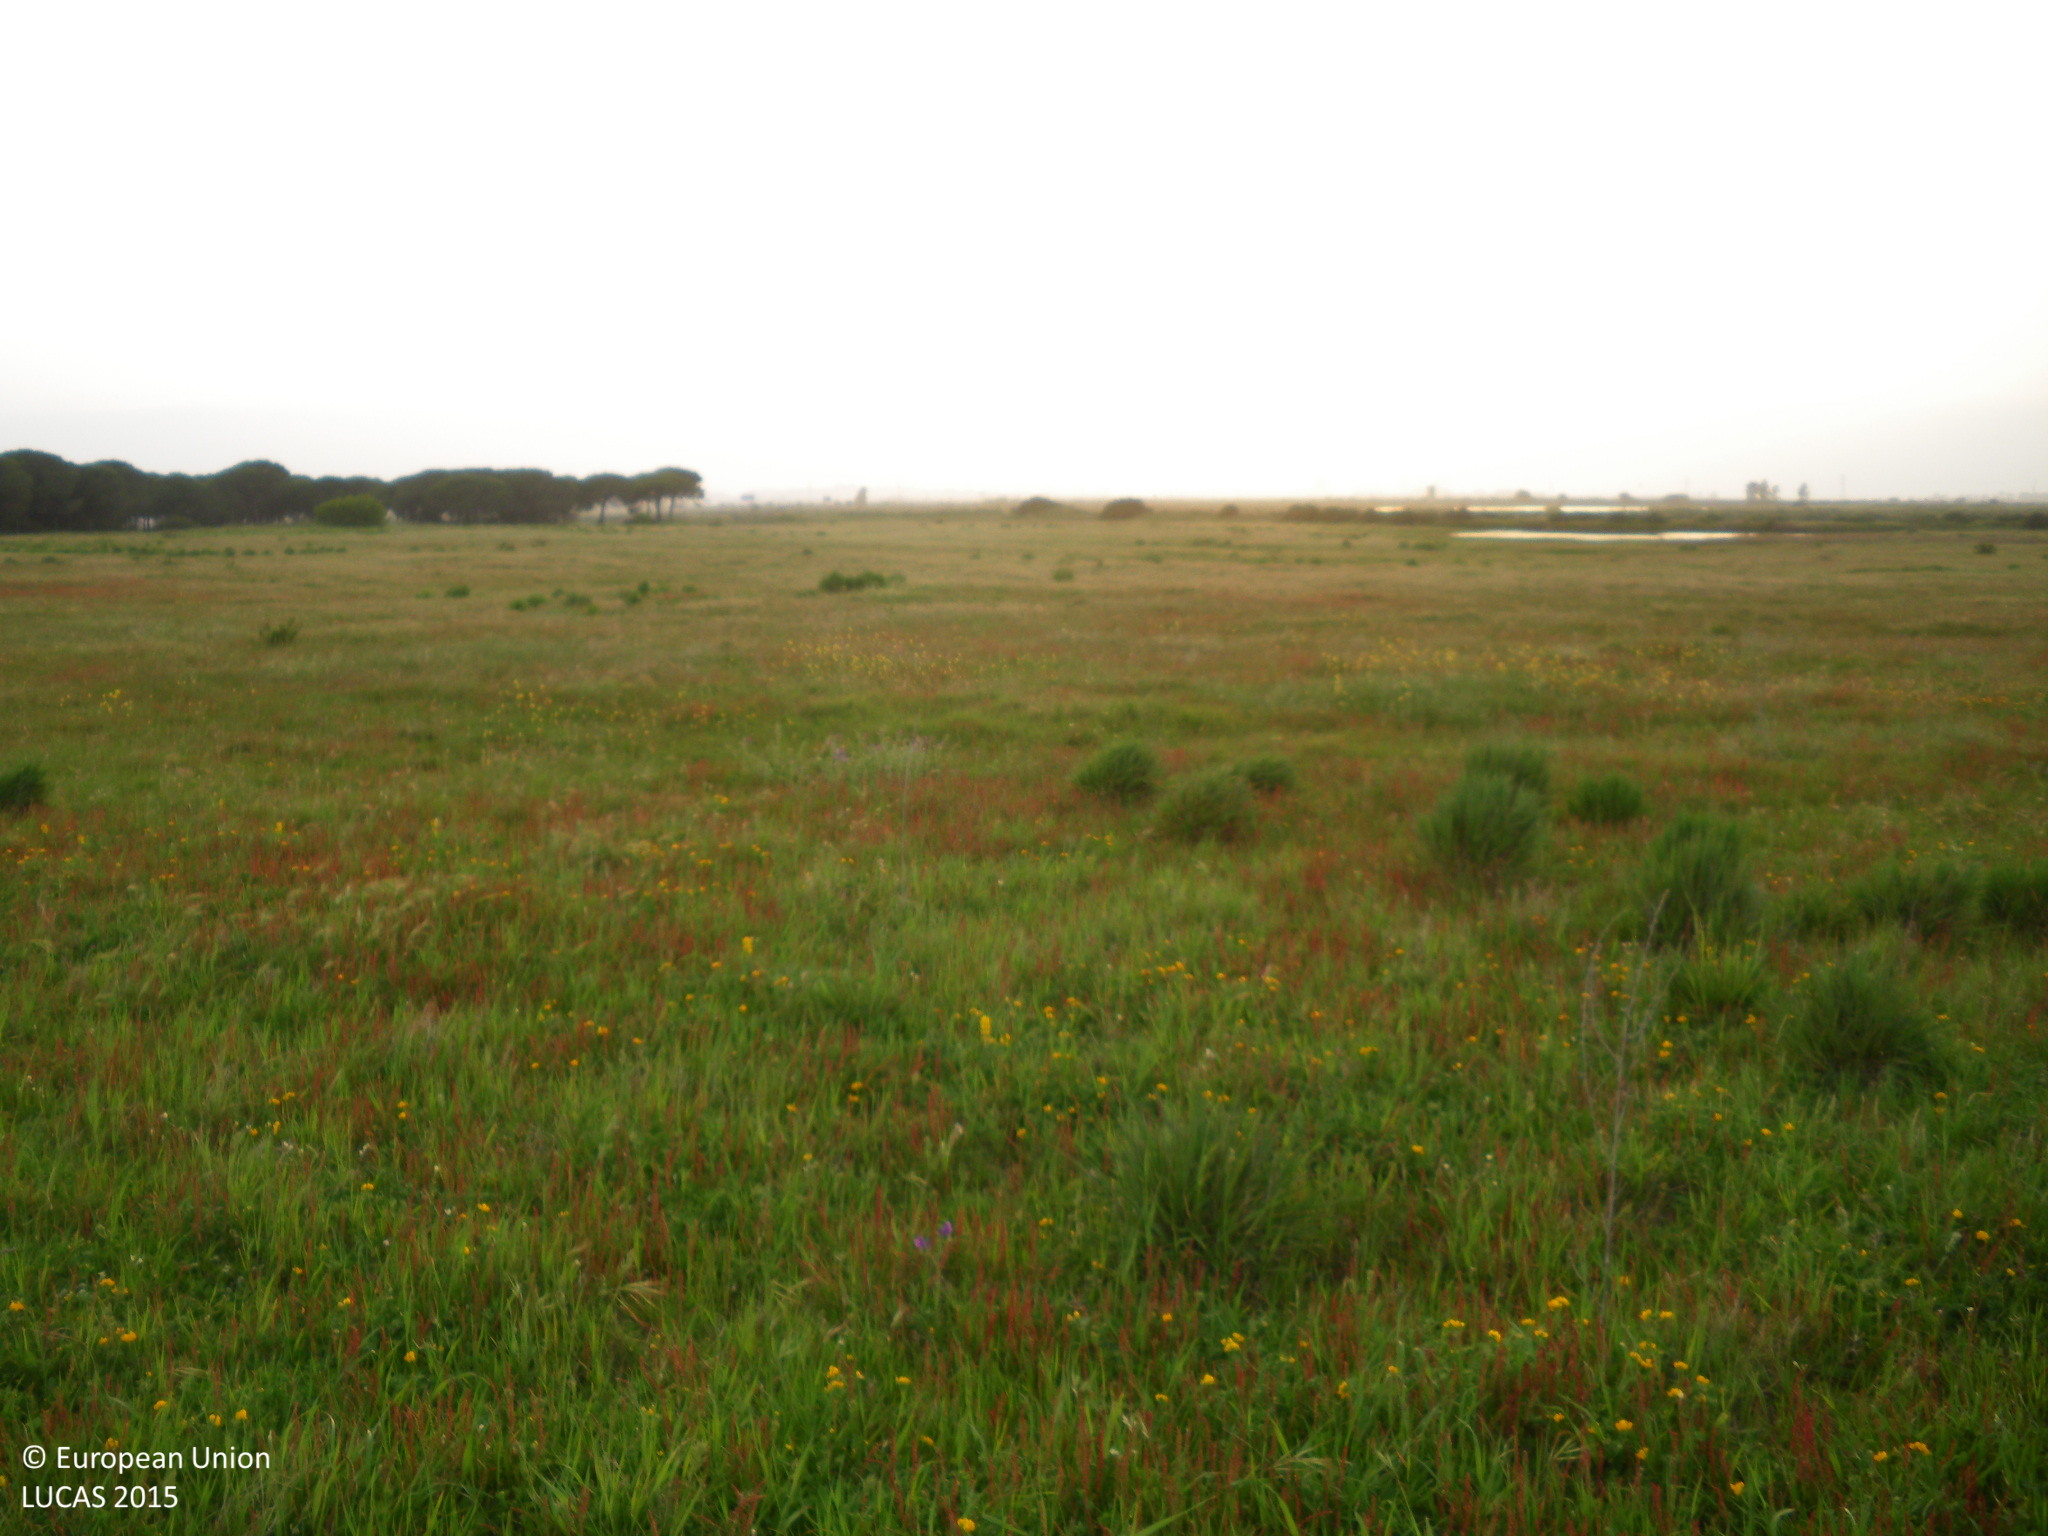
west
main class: Grassland
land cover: Spontaneously vegetated surfaces
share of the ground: > 75 %
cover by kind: herbaceous plants 100 %
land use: Fallow land
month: April
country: ES
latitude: 36.4707
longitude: -6.1342
